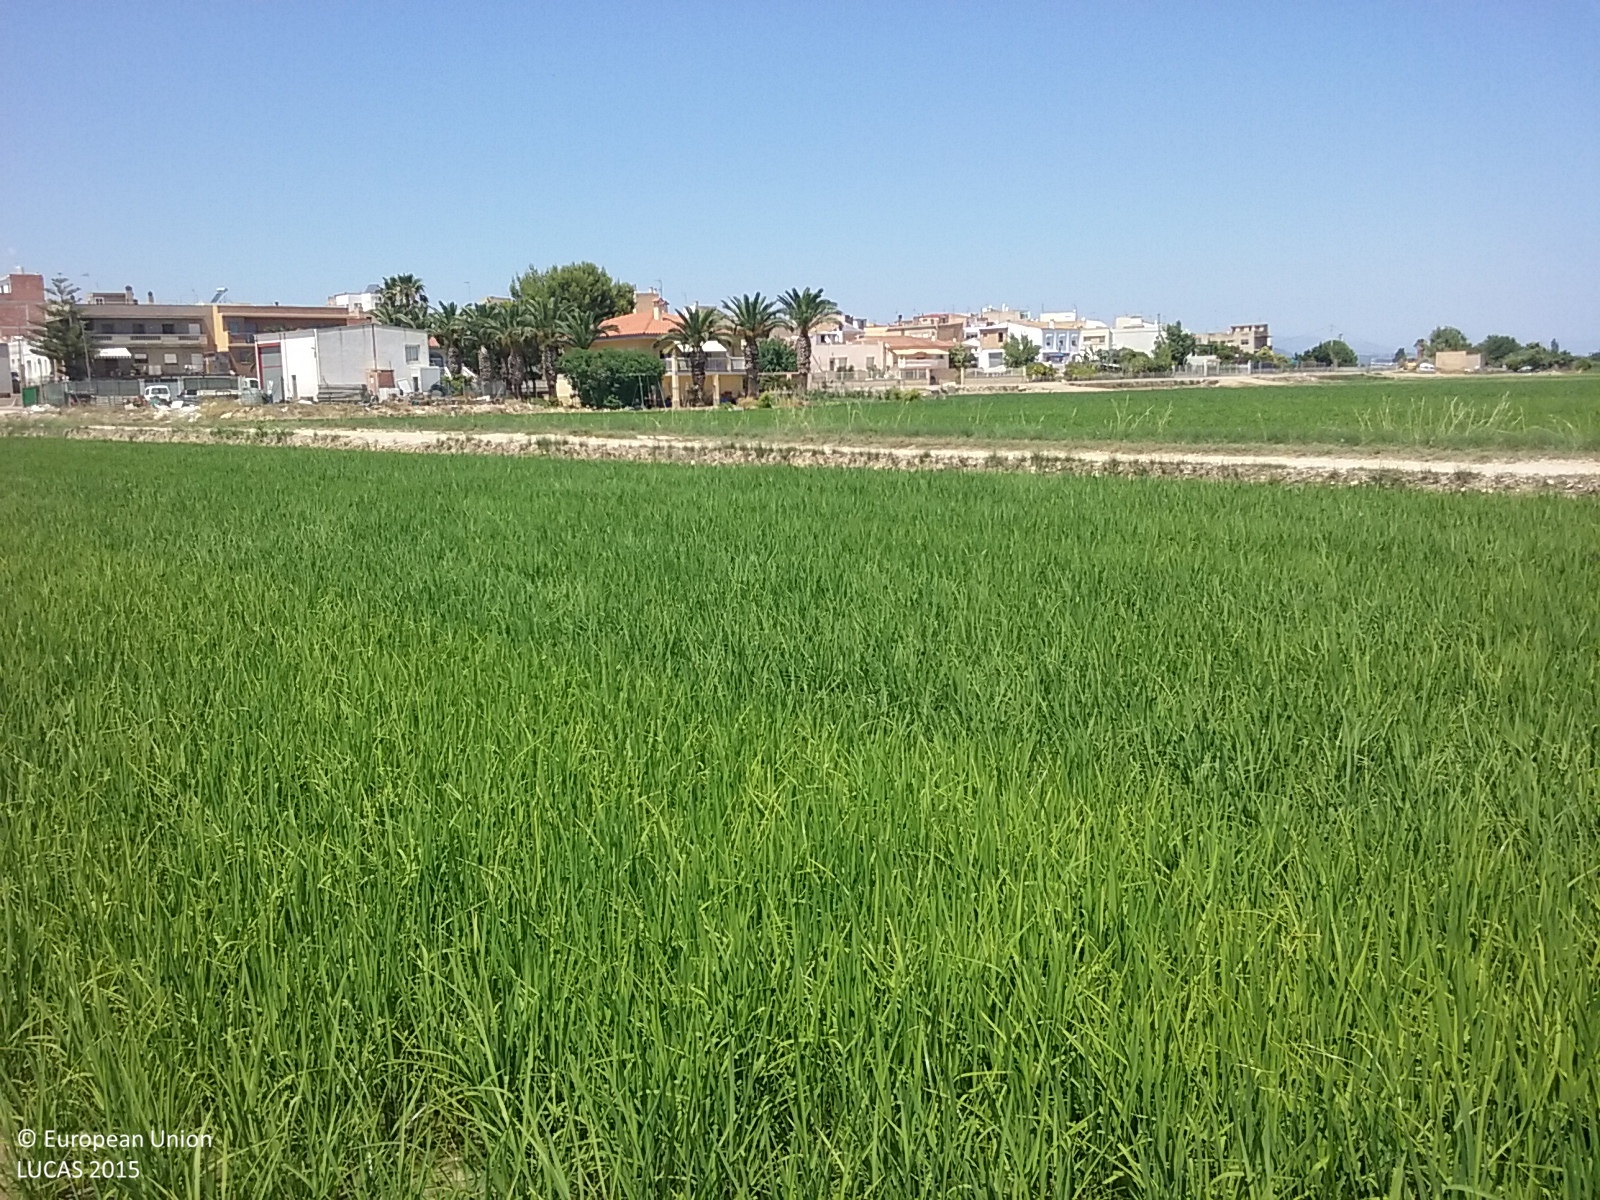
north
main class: Cropland
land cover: Rice
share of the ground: 50 - 75 %
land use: Agriculture (excluding fallow land and kitchen gardens)
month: June
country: ES
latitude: 40.7682
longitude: 0.6711
